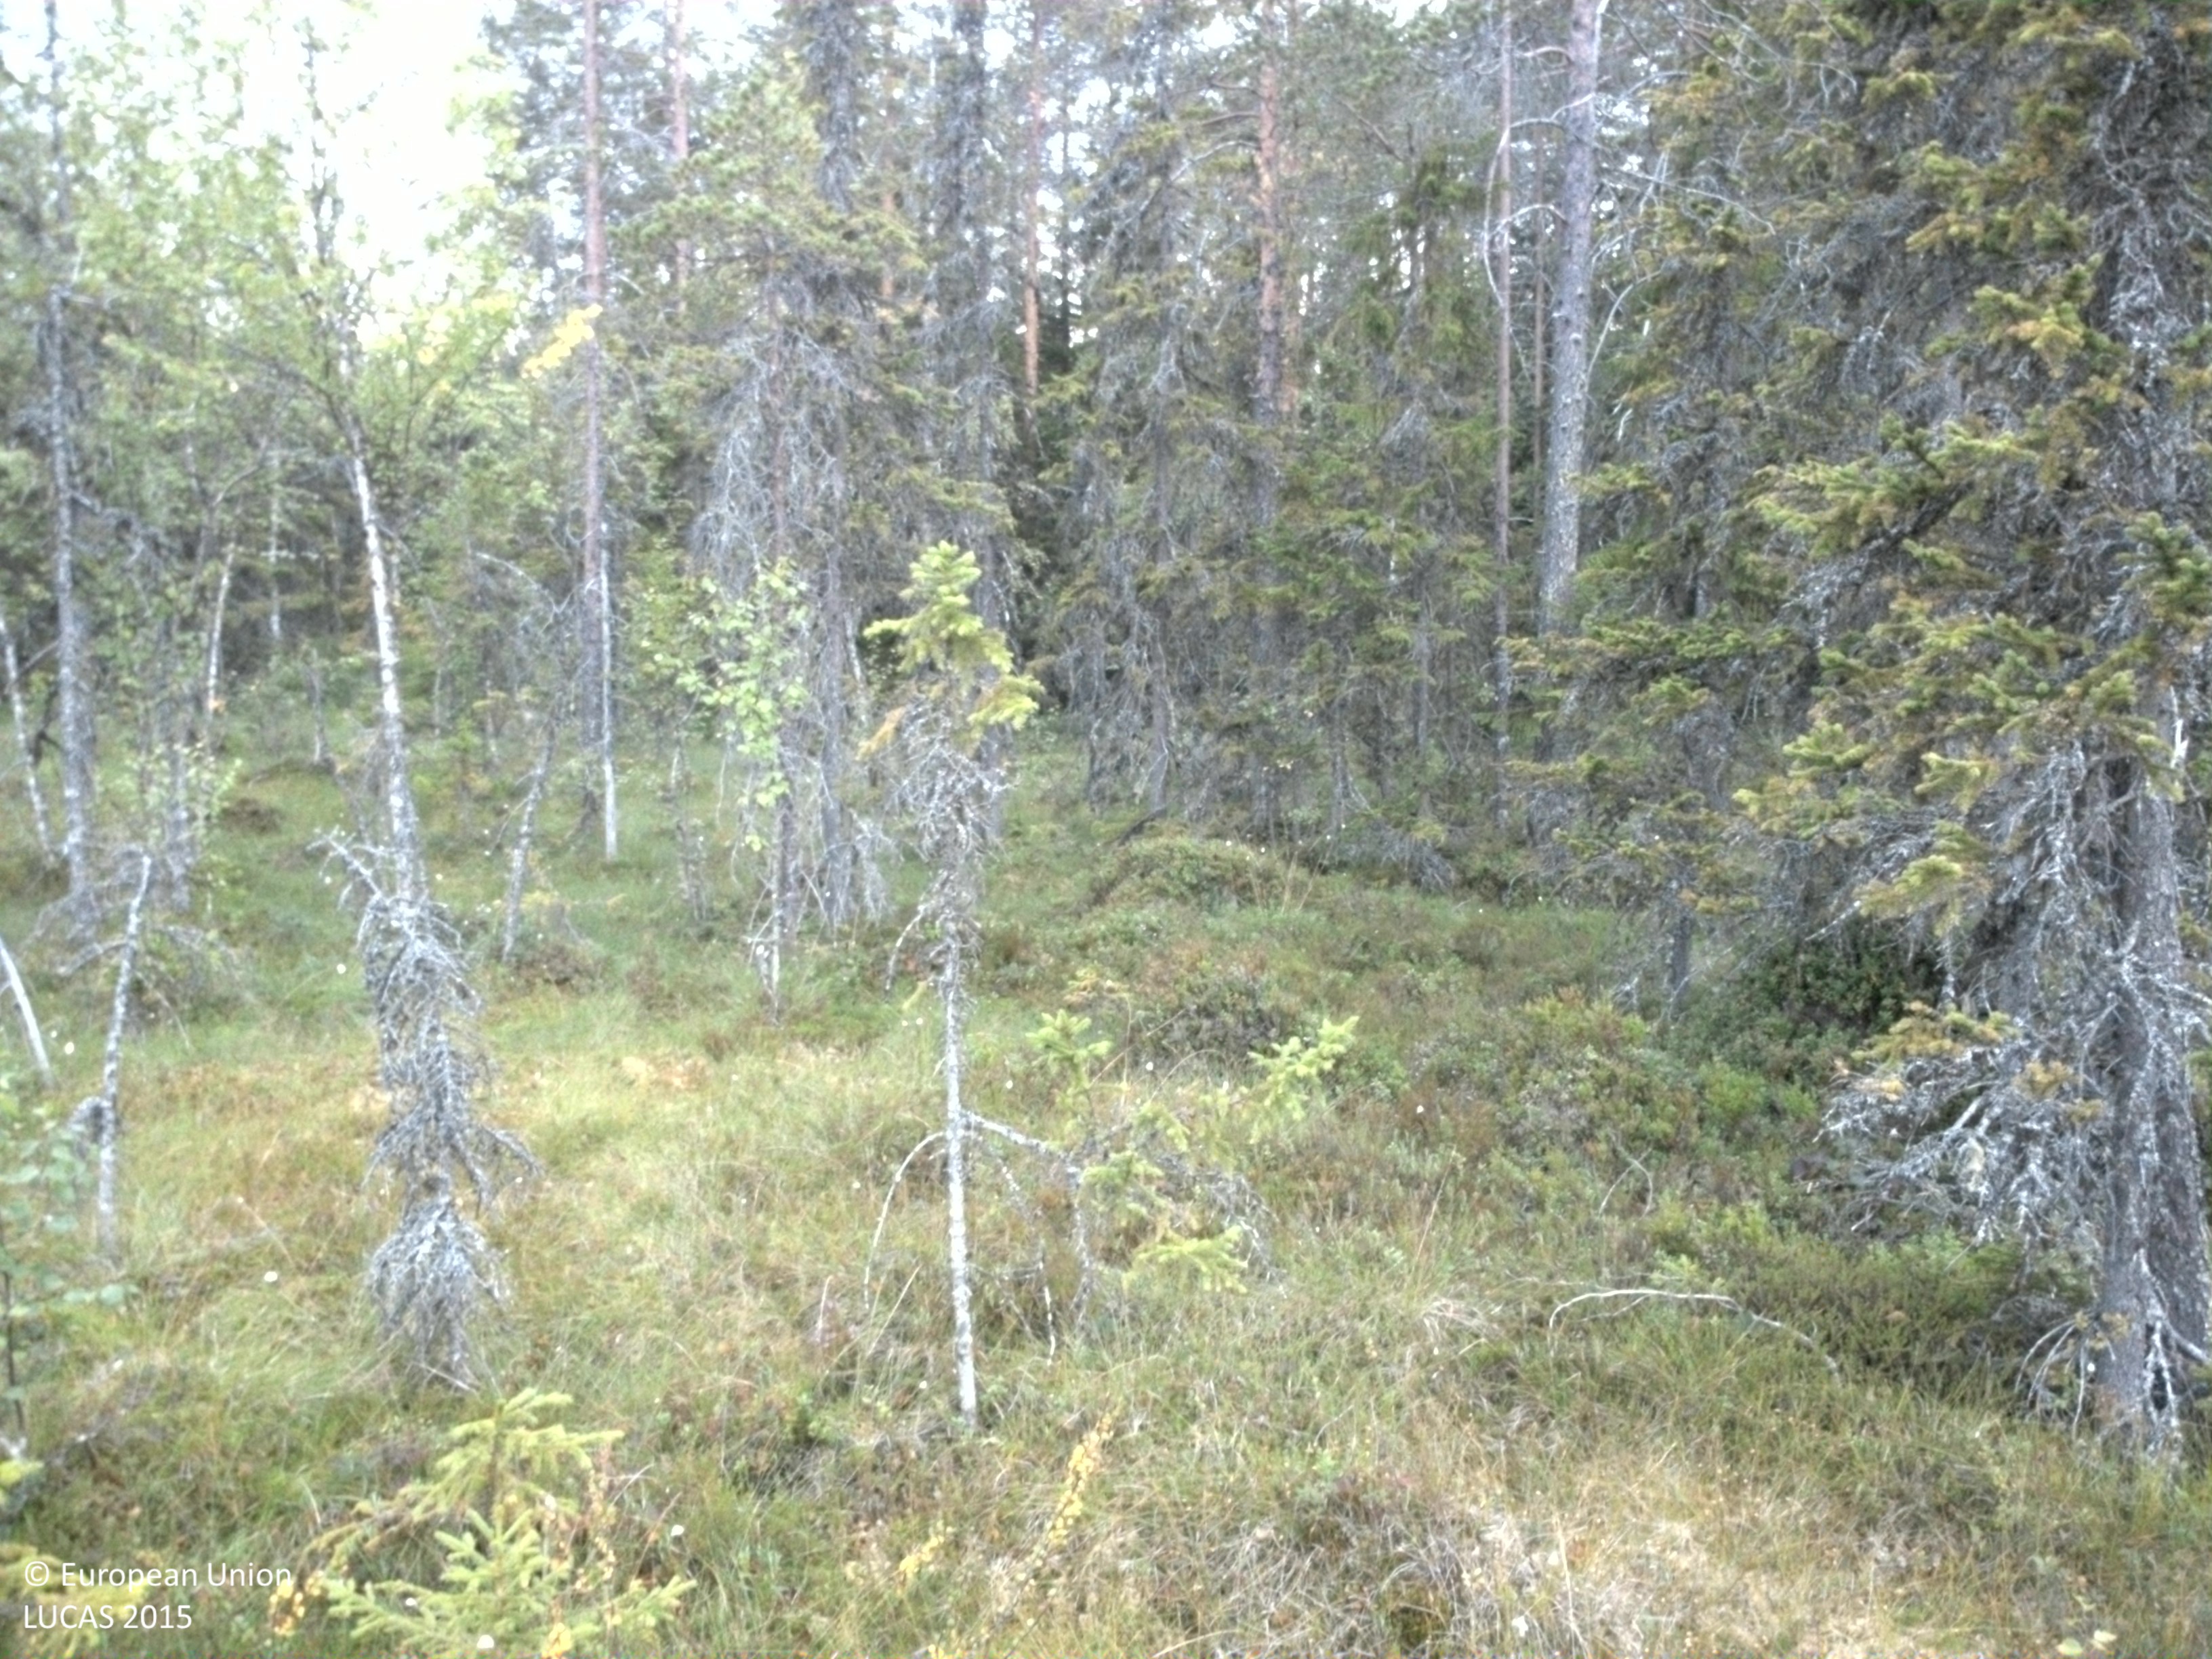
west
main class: Woodland
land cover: Other mixed woodland
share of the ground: 25 - 50 %
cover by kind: shrubs 25 %, lichens and mosses 25 %, coniferous forest trees 20 %, broadleaved forest trees 15 %, herbaceous plants 15 %
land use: Forestry
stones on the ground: < 10 %
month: August
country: SE
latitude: 61.7793
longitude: 15.2720
